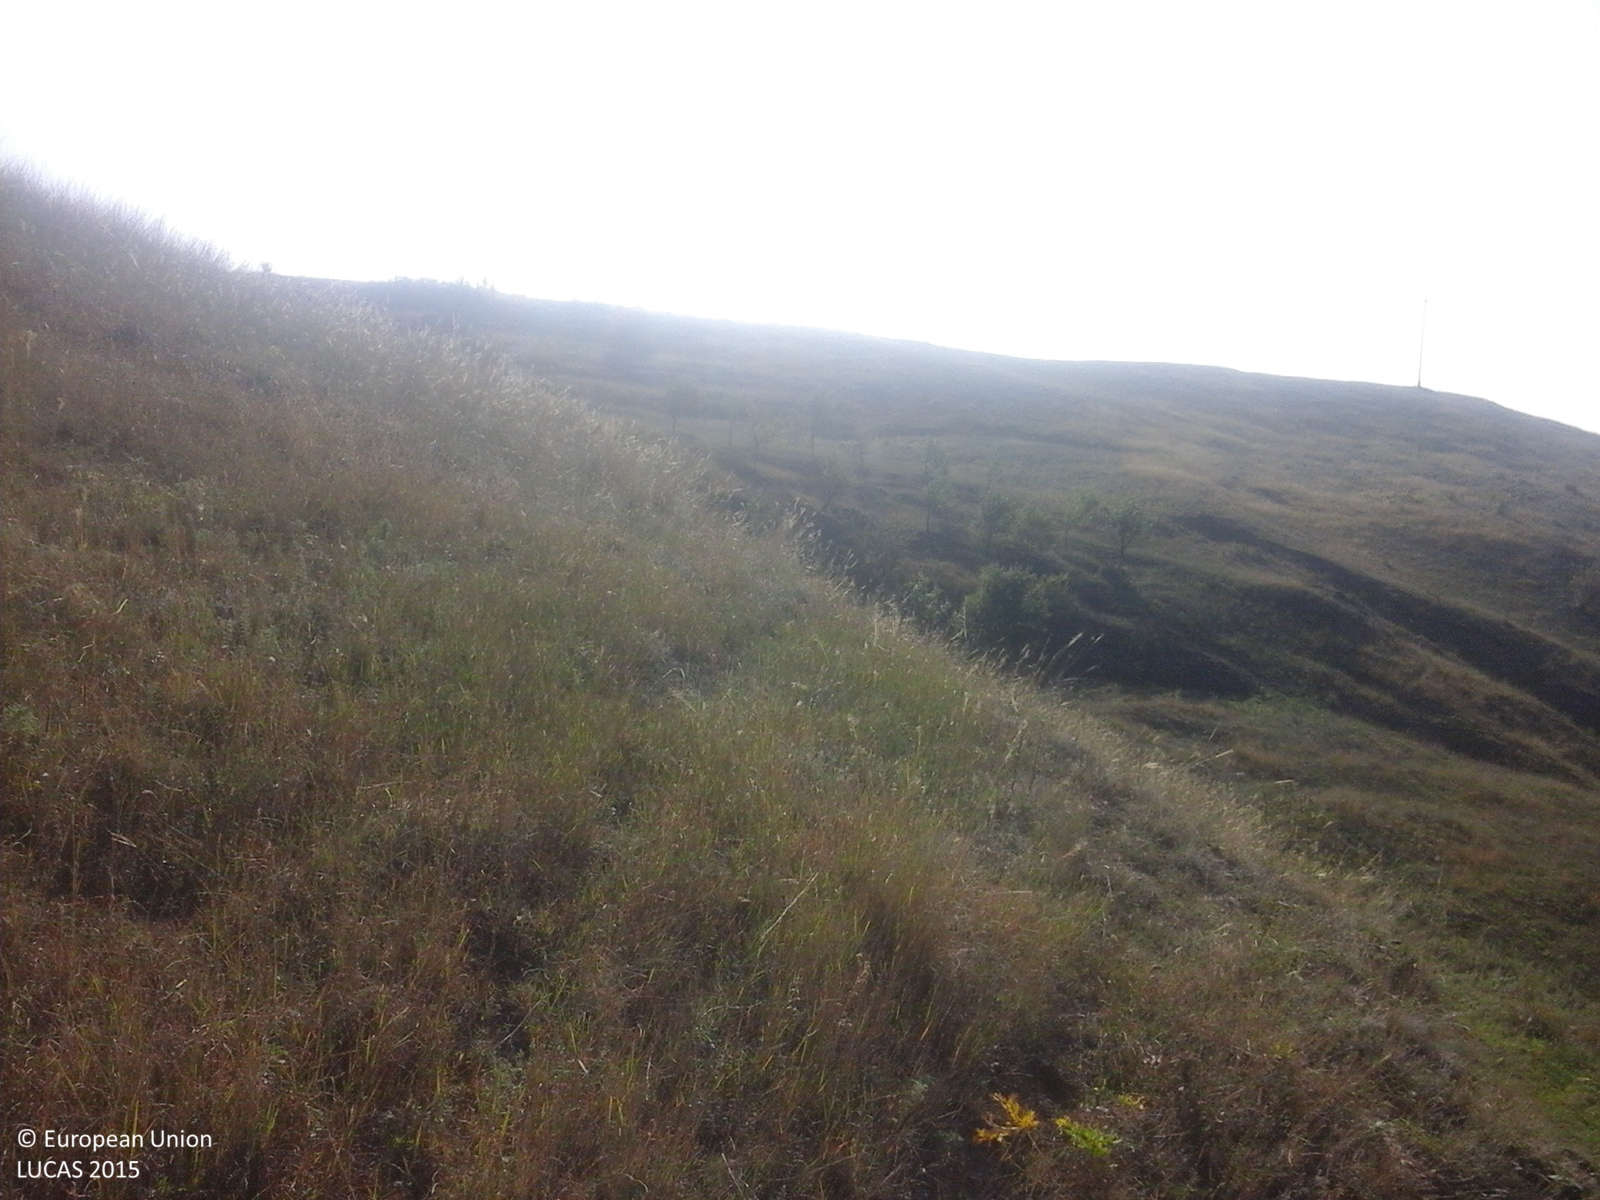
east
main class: Grassland
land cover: Grassland without tree/shrub cover
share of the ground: > 75 %
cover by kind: herbaceous plants 100 %
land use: Agriculture (excluding fallow land and kitchen gardens)
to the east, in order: Grassland without tree/shrub cover; Grassland with sparse tree/shrub cover; Lucerne; Spontaneously vegetated surfaces; Maize
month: September
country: RO
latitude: 46.8306
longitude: 24.2826
